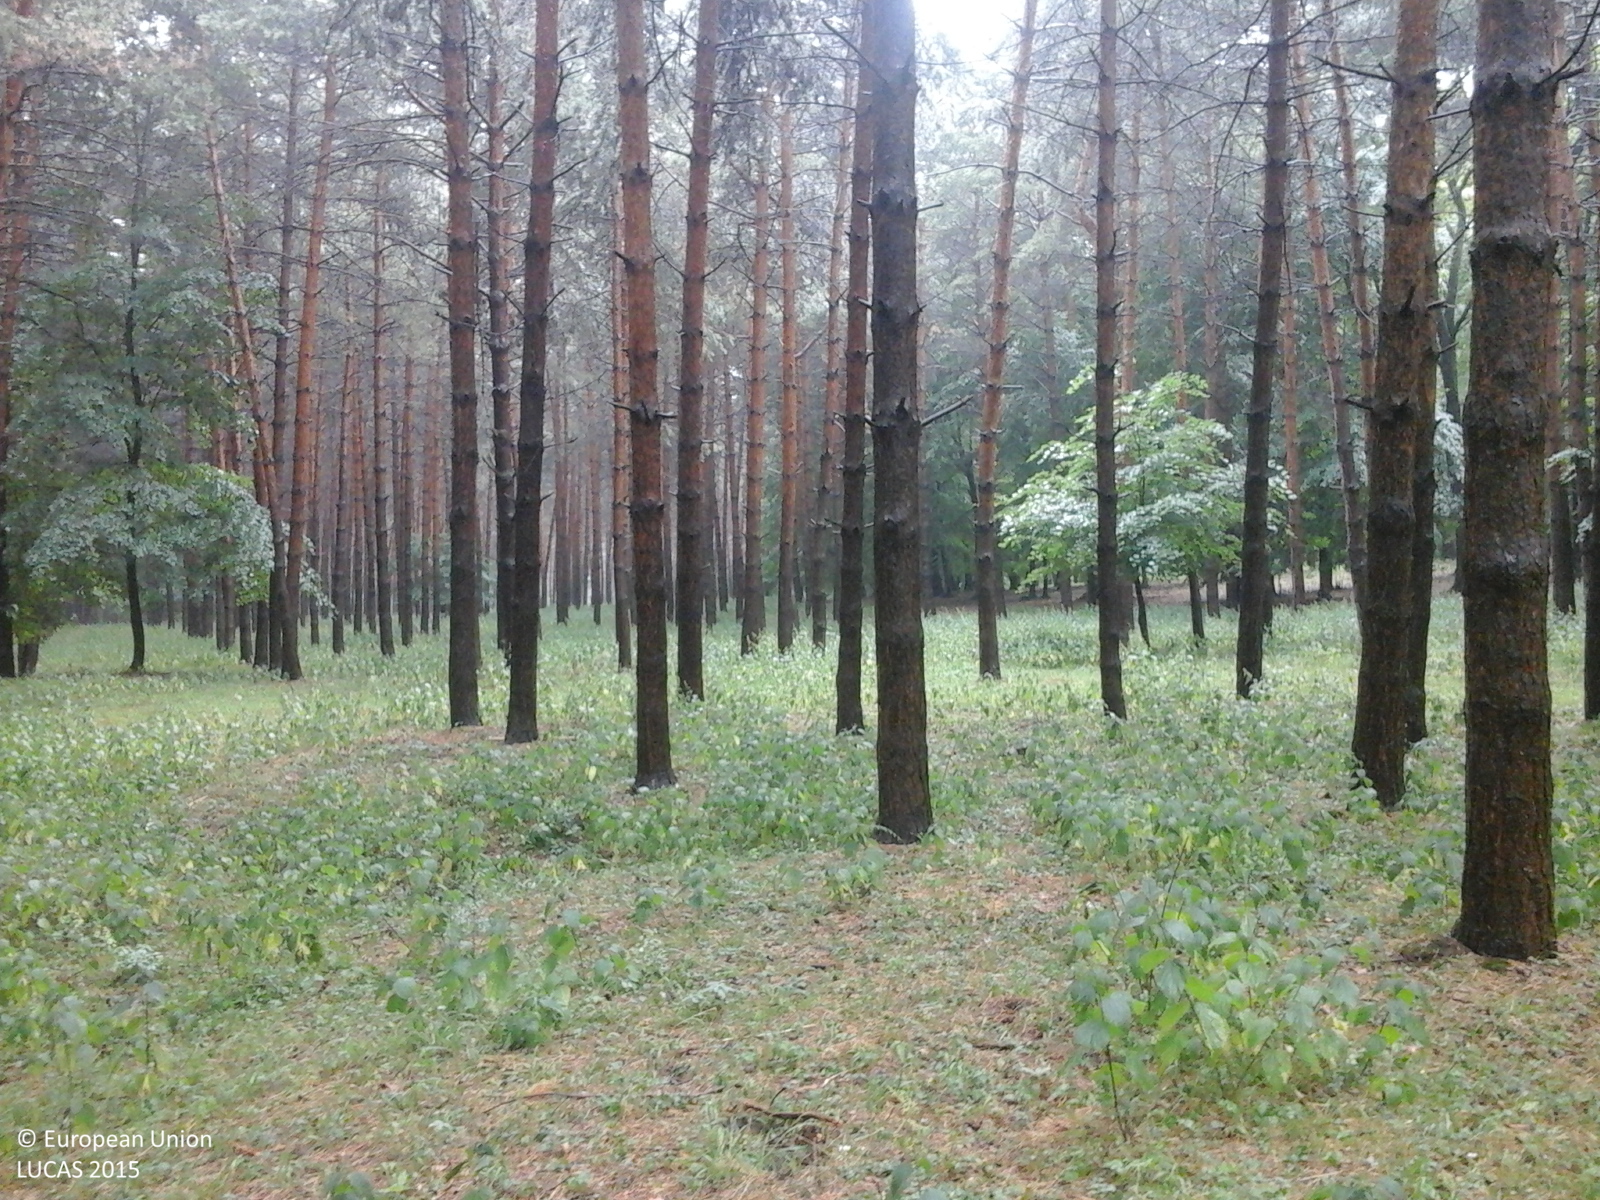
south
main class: Woodland
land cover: Pine dominated coniferous woodland
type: hemiboreal forest and nemoral coniferous forest and mixed broadleaved-coniferous forest
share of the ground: > 75 %
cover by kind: coniferous forest trees 95 %, broadleaved forest trees 5 %
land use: Forestry
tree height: > 5 m
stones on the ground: 10 - 25 %
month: June
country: RO
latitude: 47.3908
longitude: 26.8567
